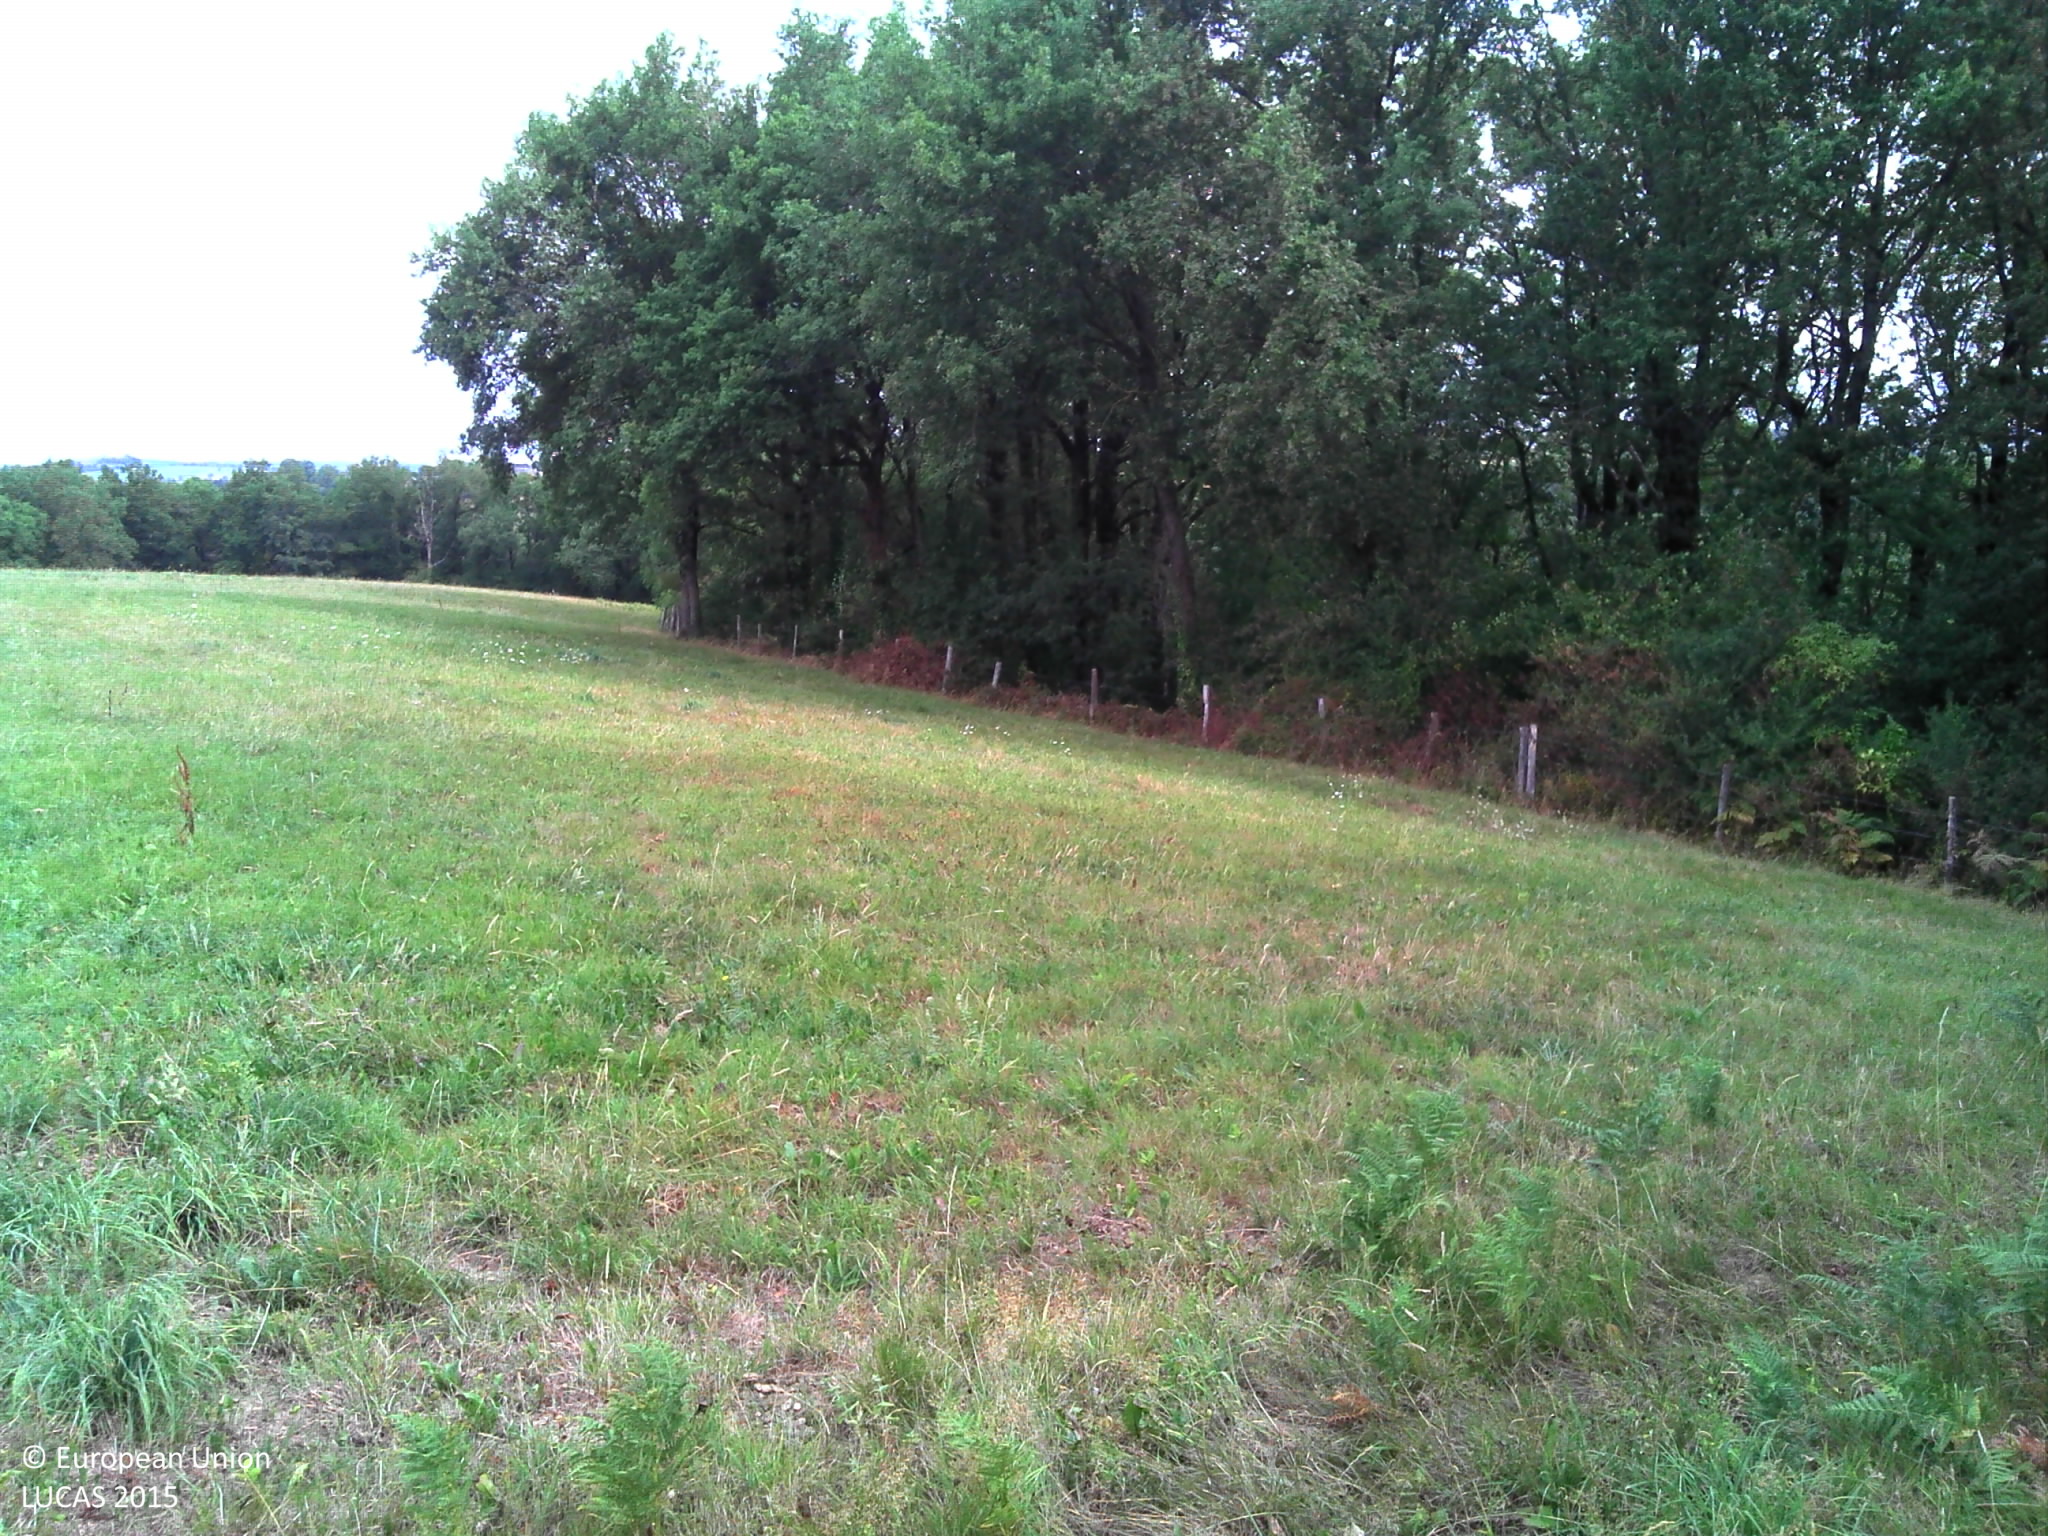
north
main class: Grassland
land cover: Grassland without tree/shrub cover
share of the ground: > 75 %
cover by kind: herbaceous plants 100 %
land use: Agriculture (excluding fallow land and kitchen gardens)
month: July
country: FR
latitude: 44.0448
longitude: 2.5289
